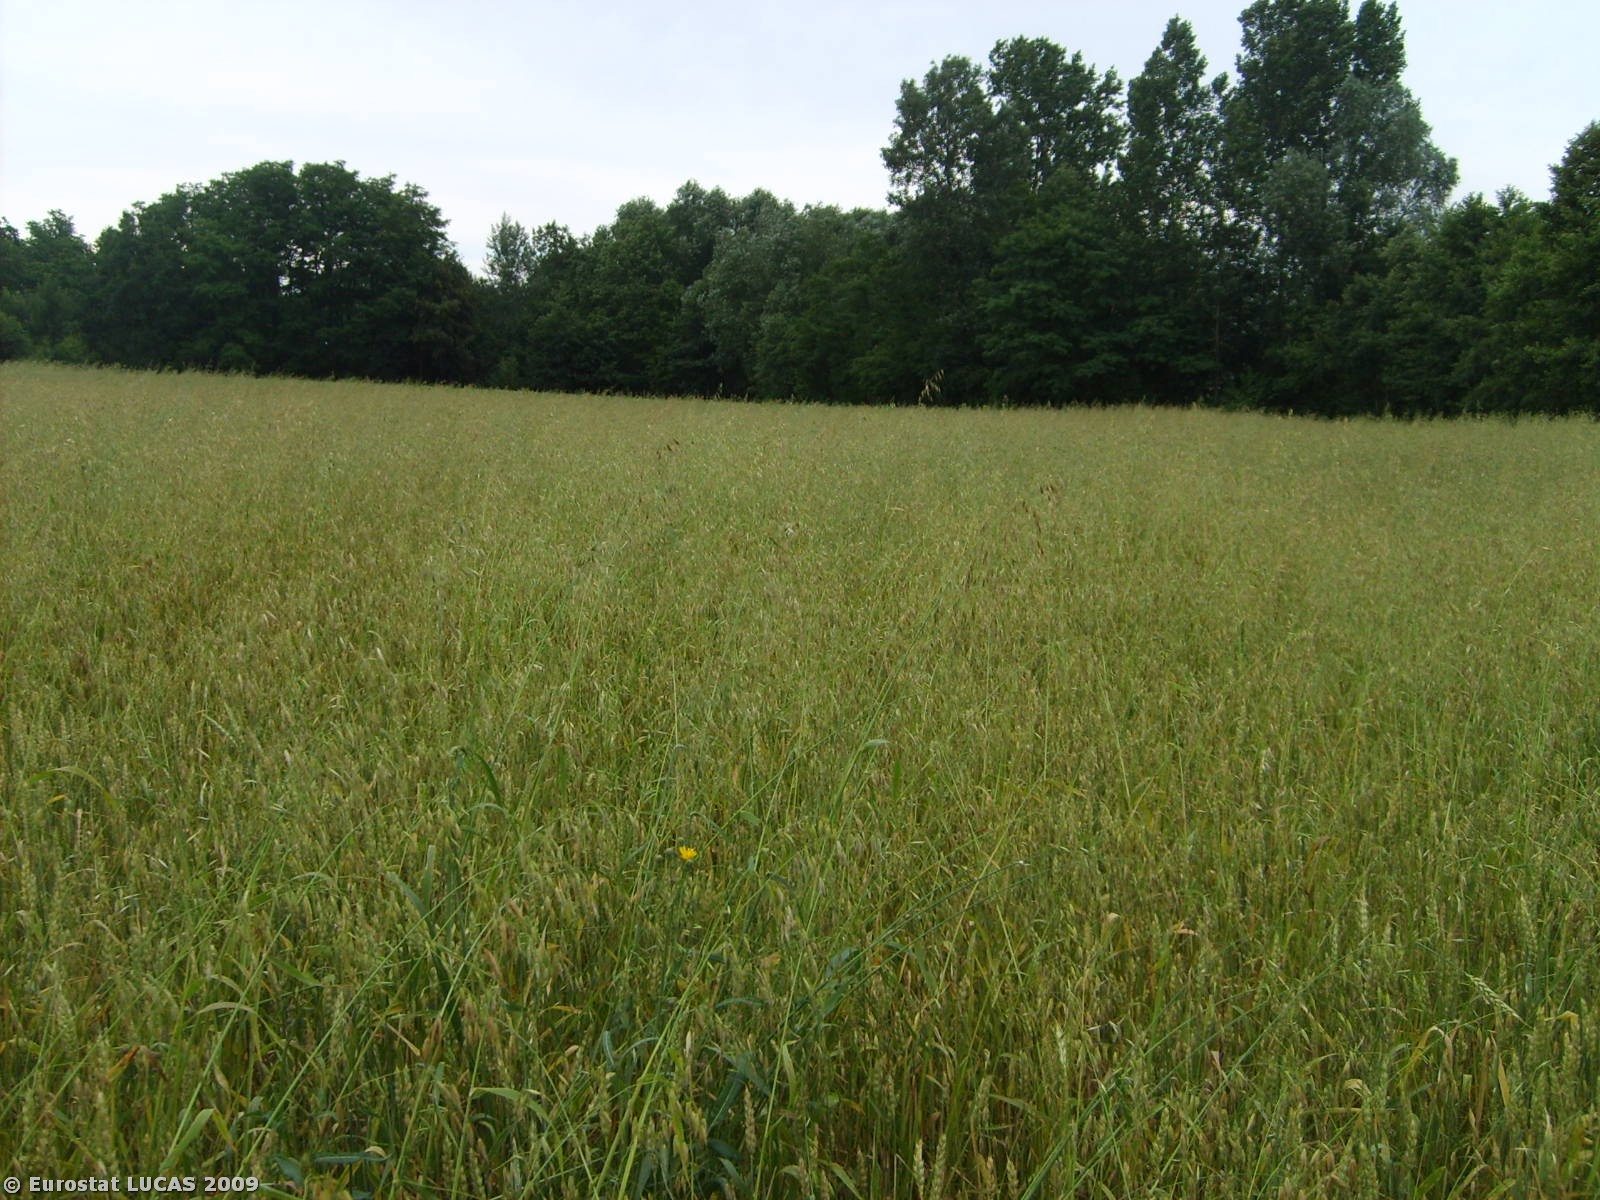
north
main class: Cropland
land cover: Mixed cereals for fodder
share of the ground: > 75 %
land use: Agriculture (excluding fallow land and kitchen gardens)
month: July
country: PL
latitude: 50.3069
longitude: 20.5836
